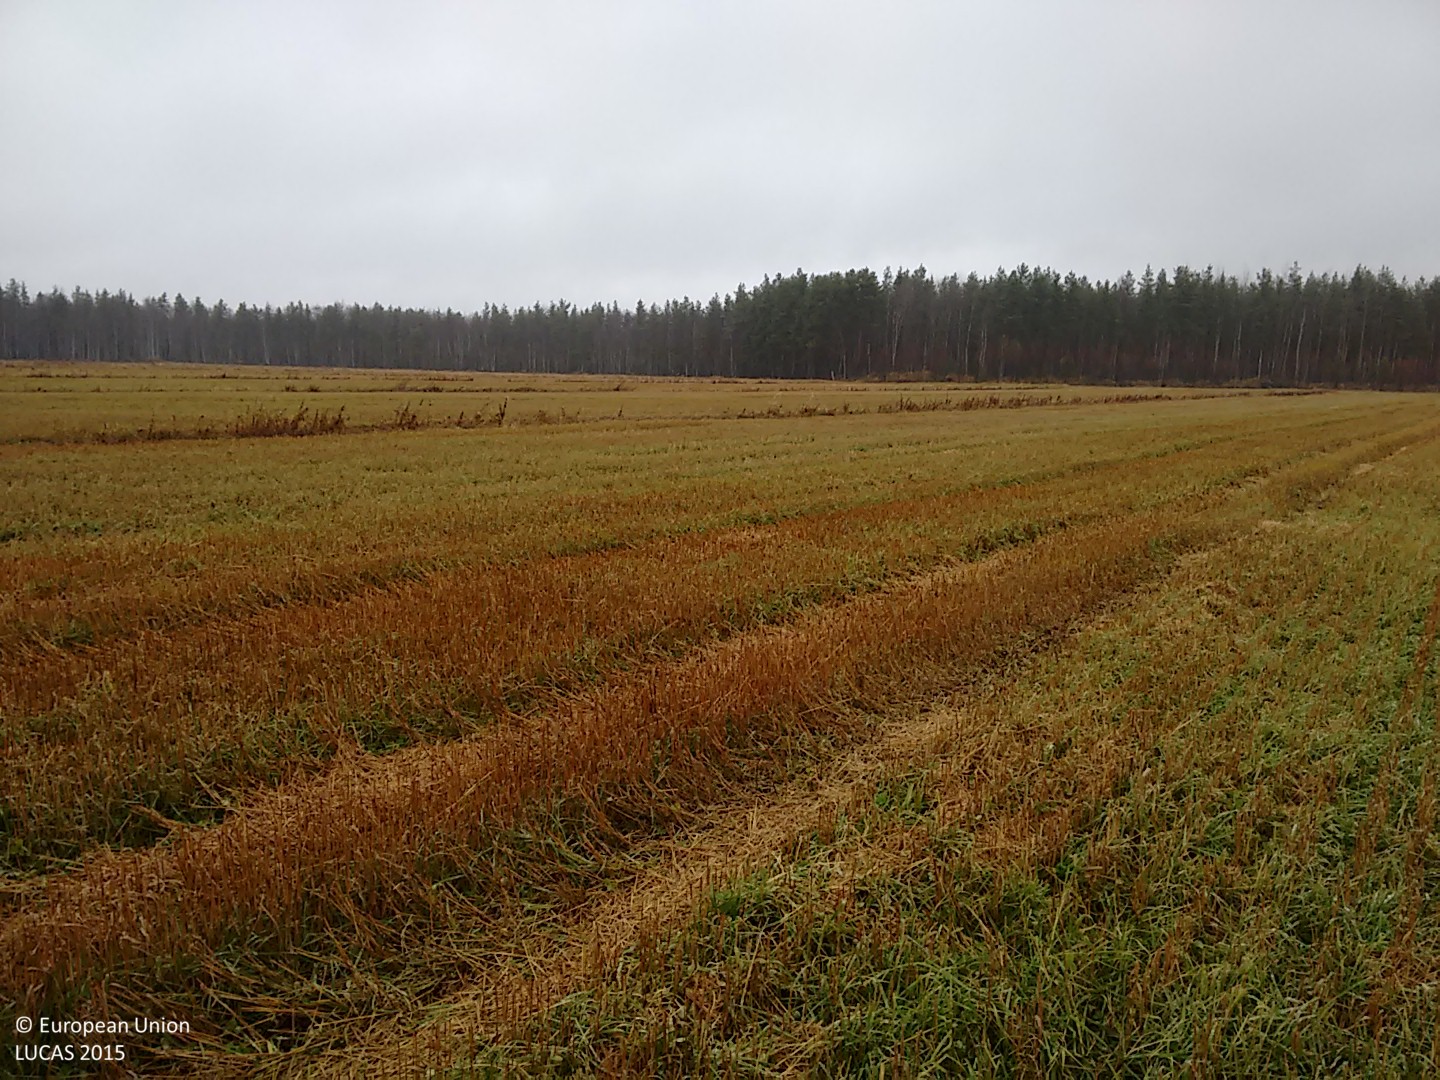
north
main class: Cropland
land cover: Barley
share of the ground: > 75 %
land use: Agriculture (excluding fallow land and kitchen gardens)
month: October
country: FI
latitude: 64.6626
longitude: 24.7532
